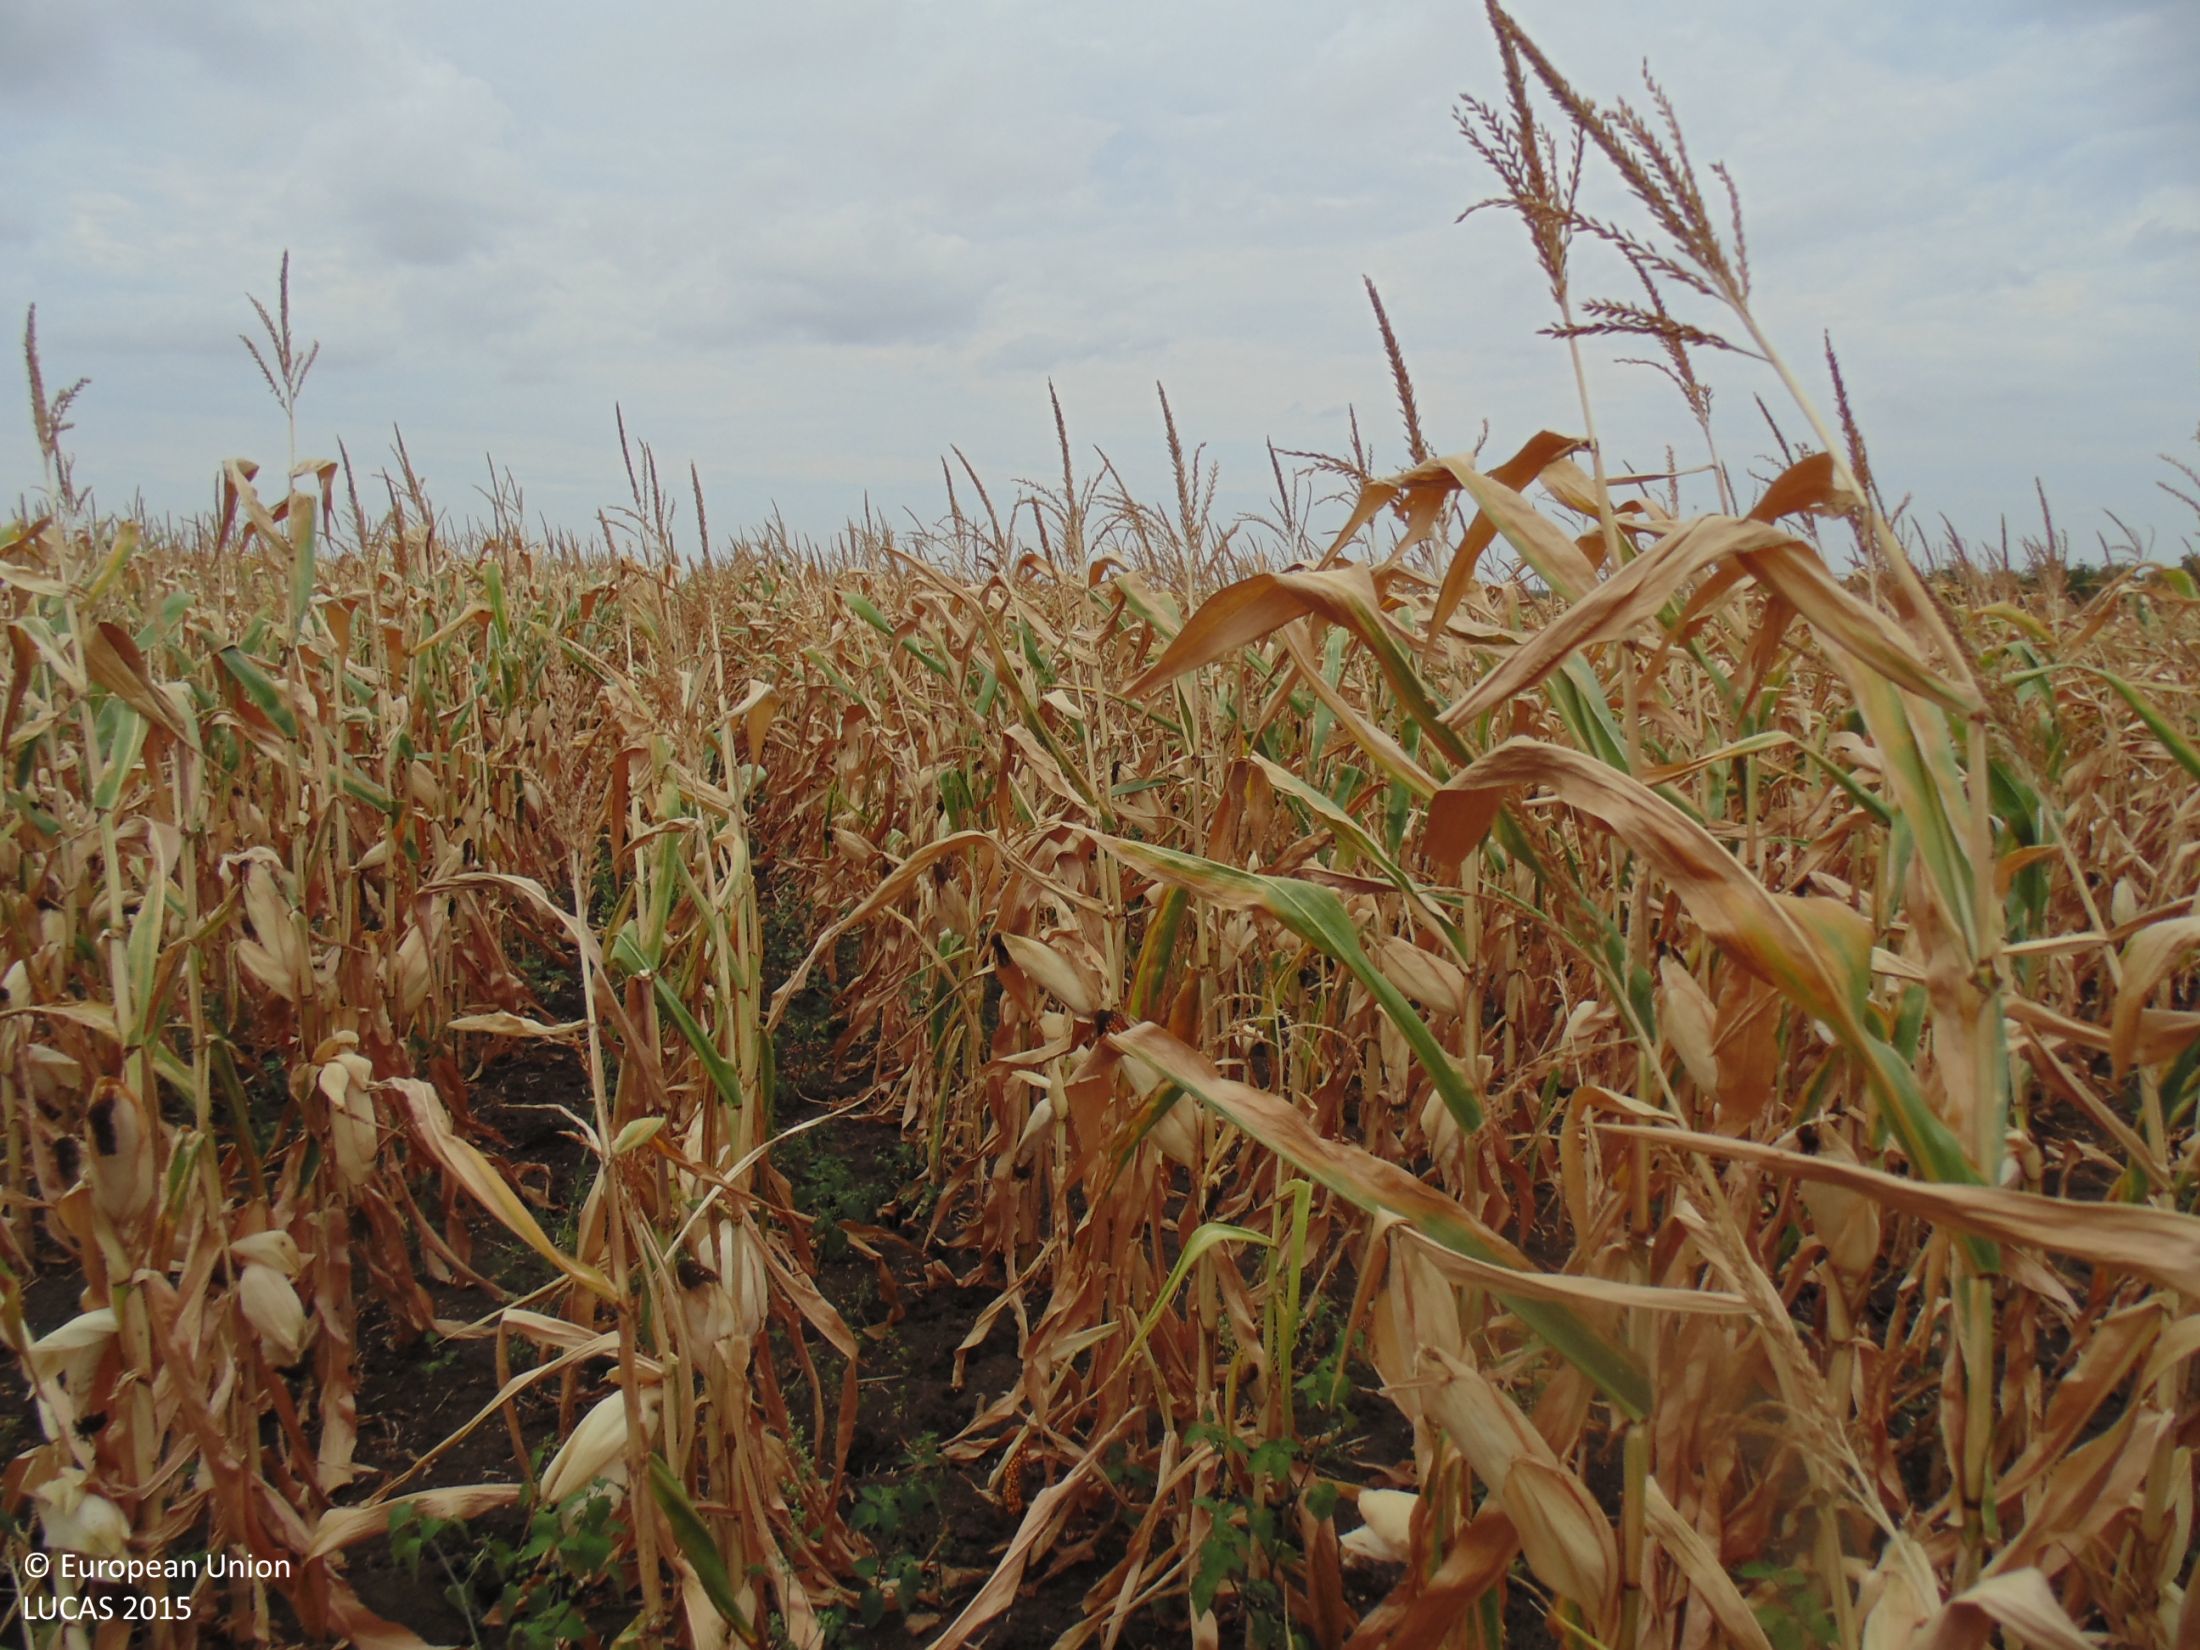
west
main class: Cropland
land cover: Maize
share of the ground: > 75 %
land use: Agriculture (excluding fallow land and kitchen gardens)
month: August
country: BG
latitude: 43.5261
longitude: 28.4595
